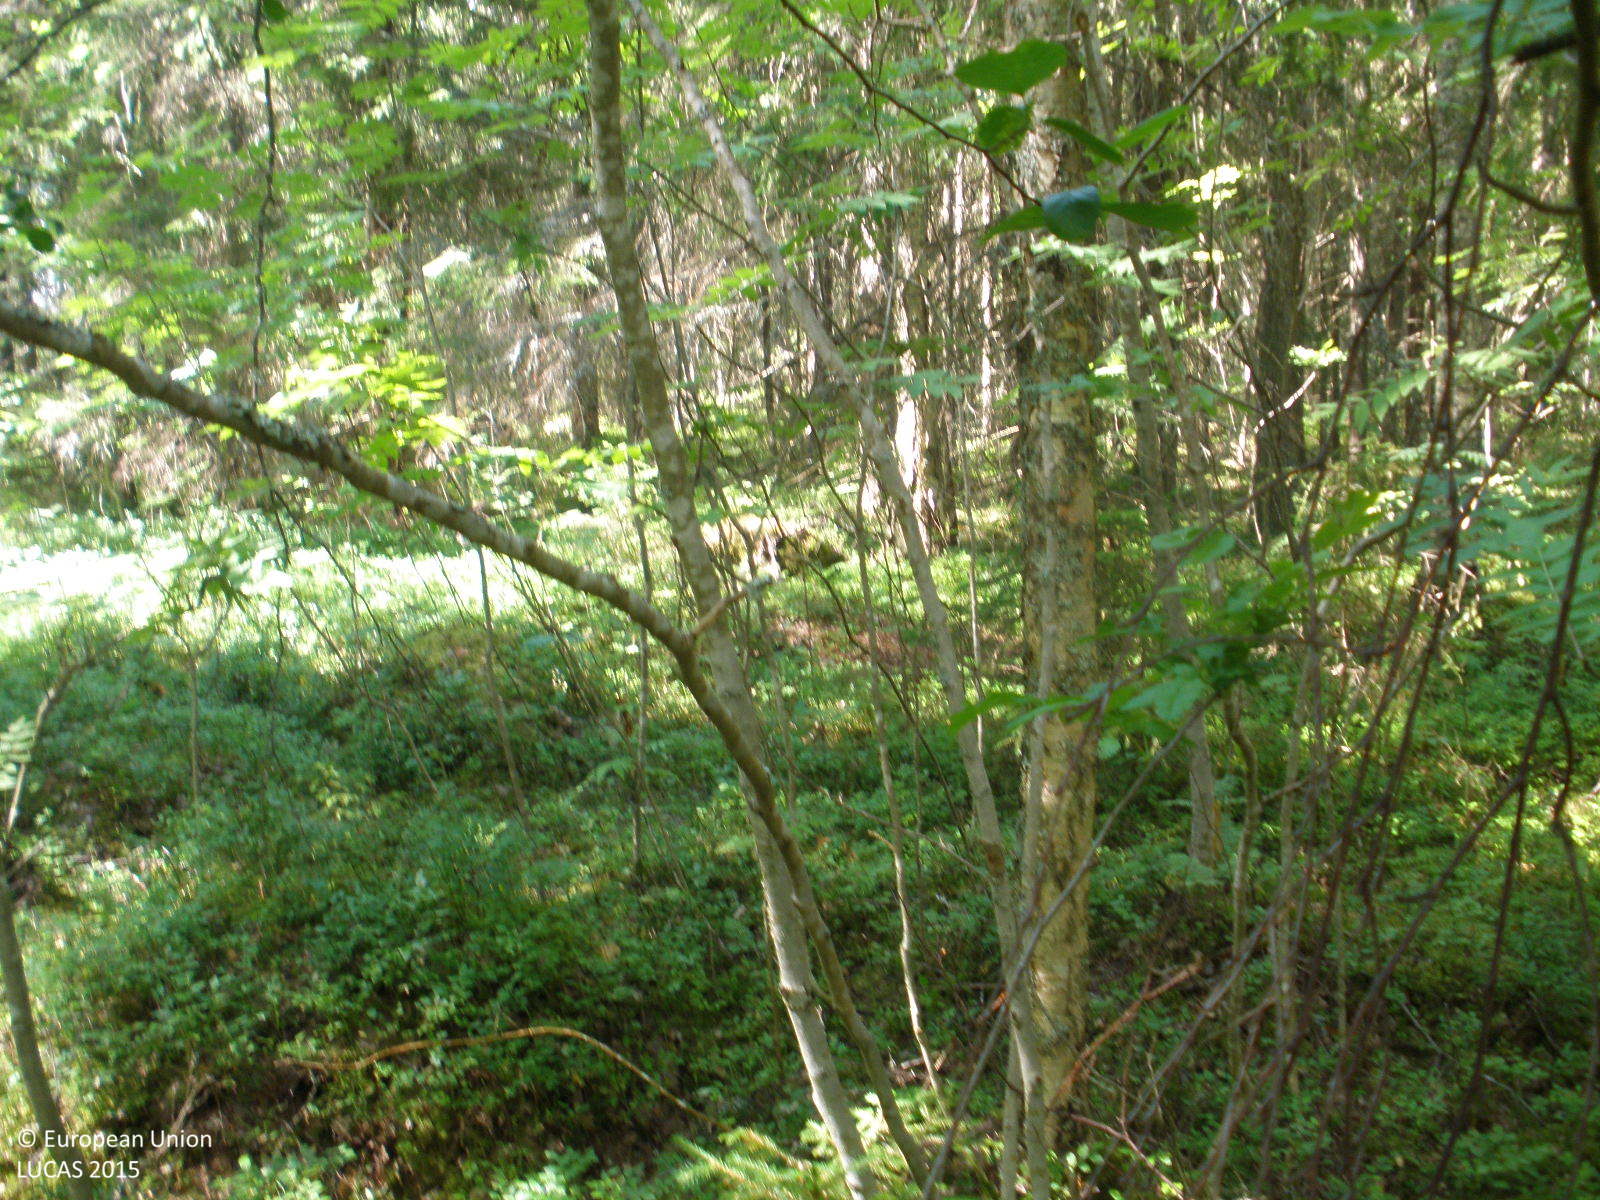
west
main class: Woodland
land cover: Spruce dominated mixed woodland
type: boreal forest
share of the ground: > 75 %
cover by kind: coniferous forest trees 60 %, broadleaved forest trees 25 %, herbaceous plants 10 %, lichens and mosses 5 %
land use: Forestry
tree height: > 5 m
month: July
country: FI
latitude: 61.6053
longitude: 24.5571
